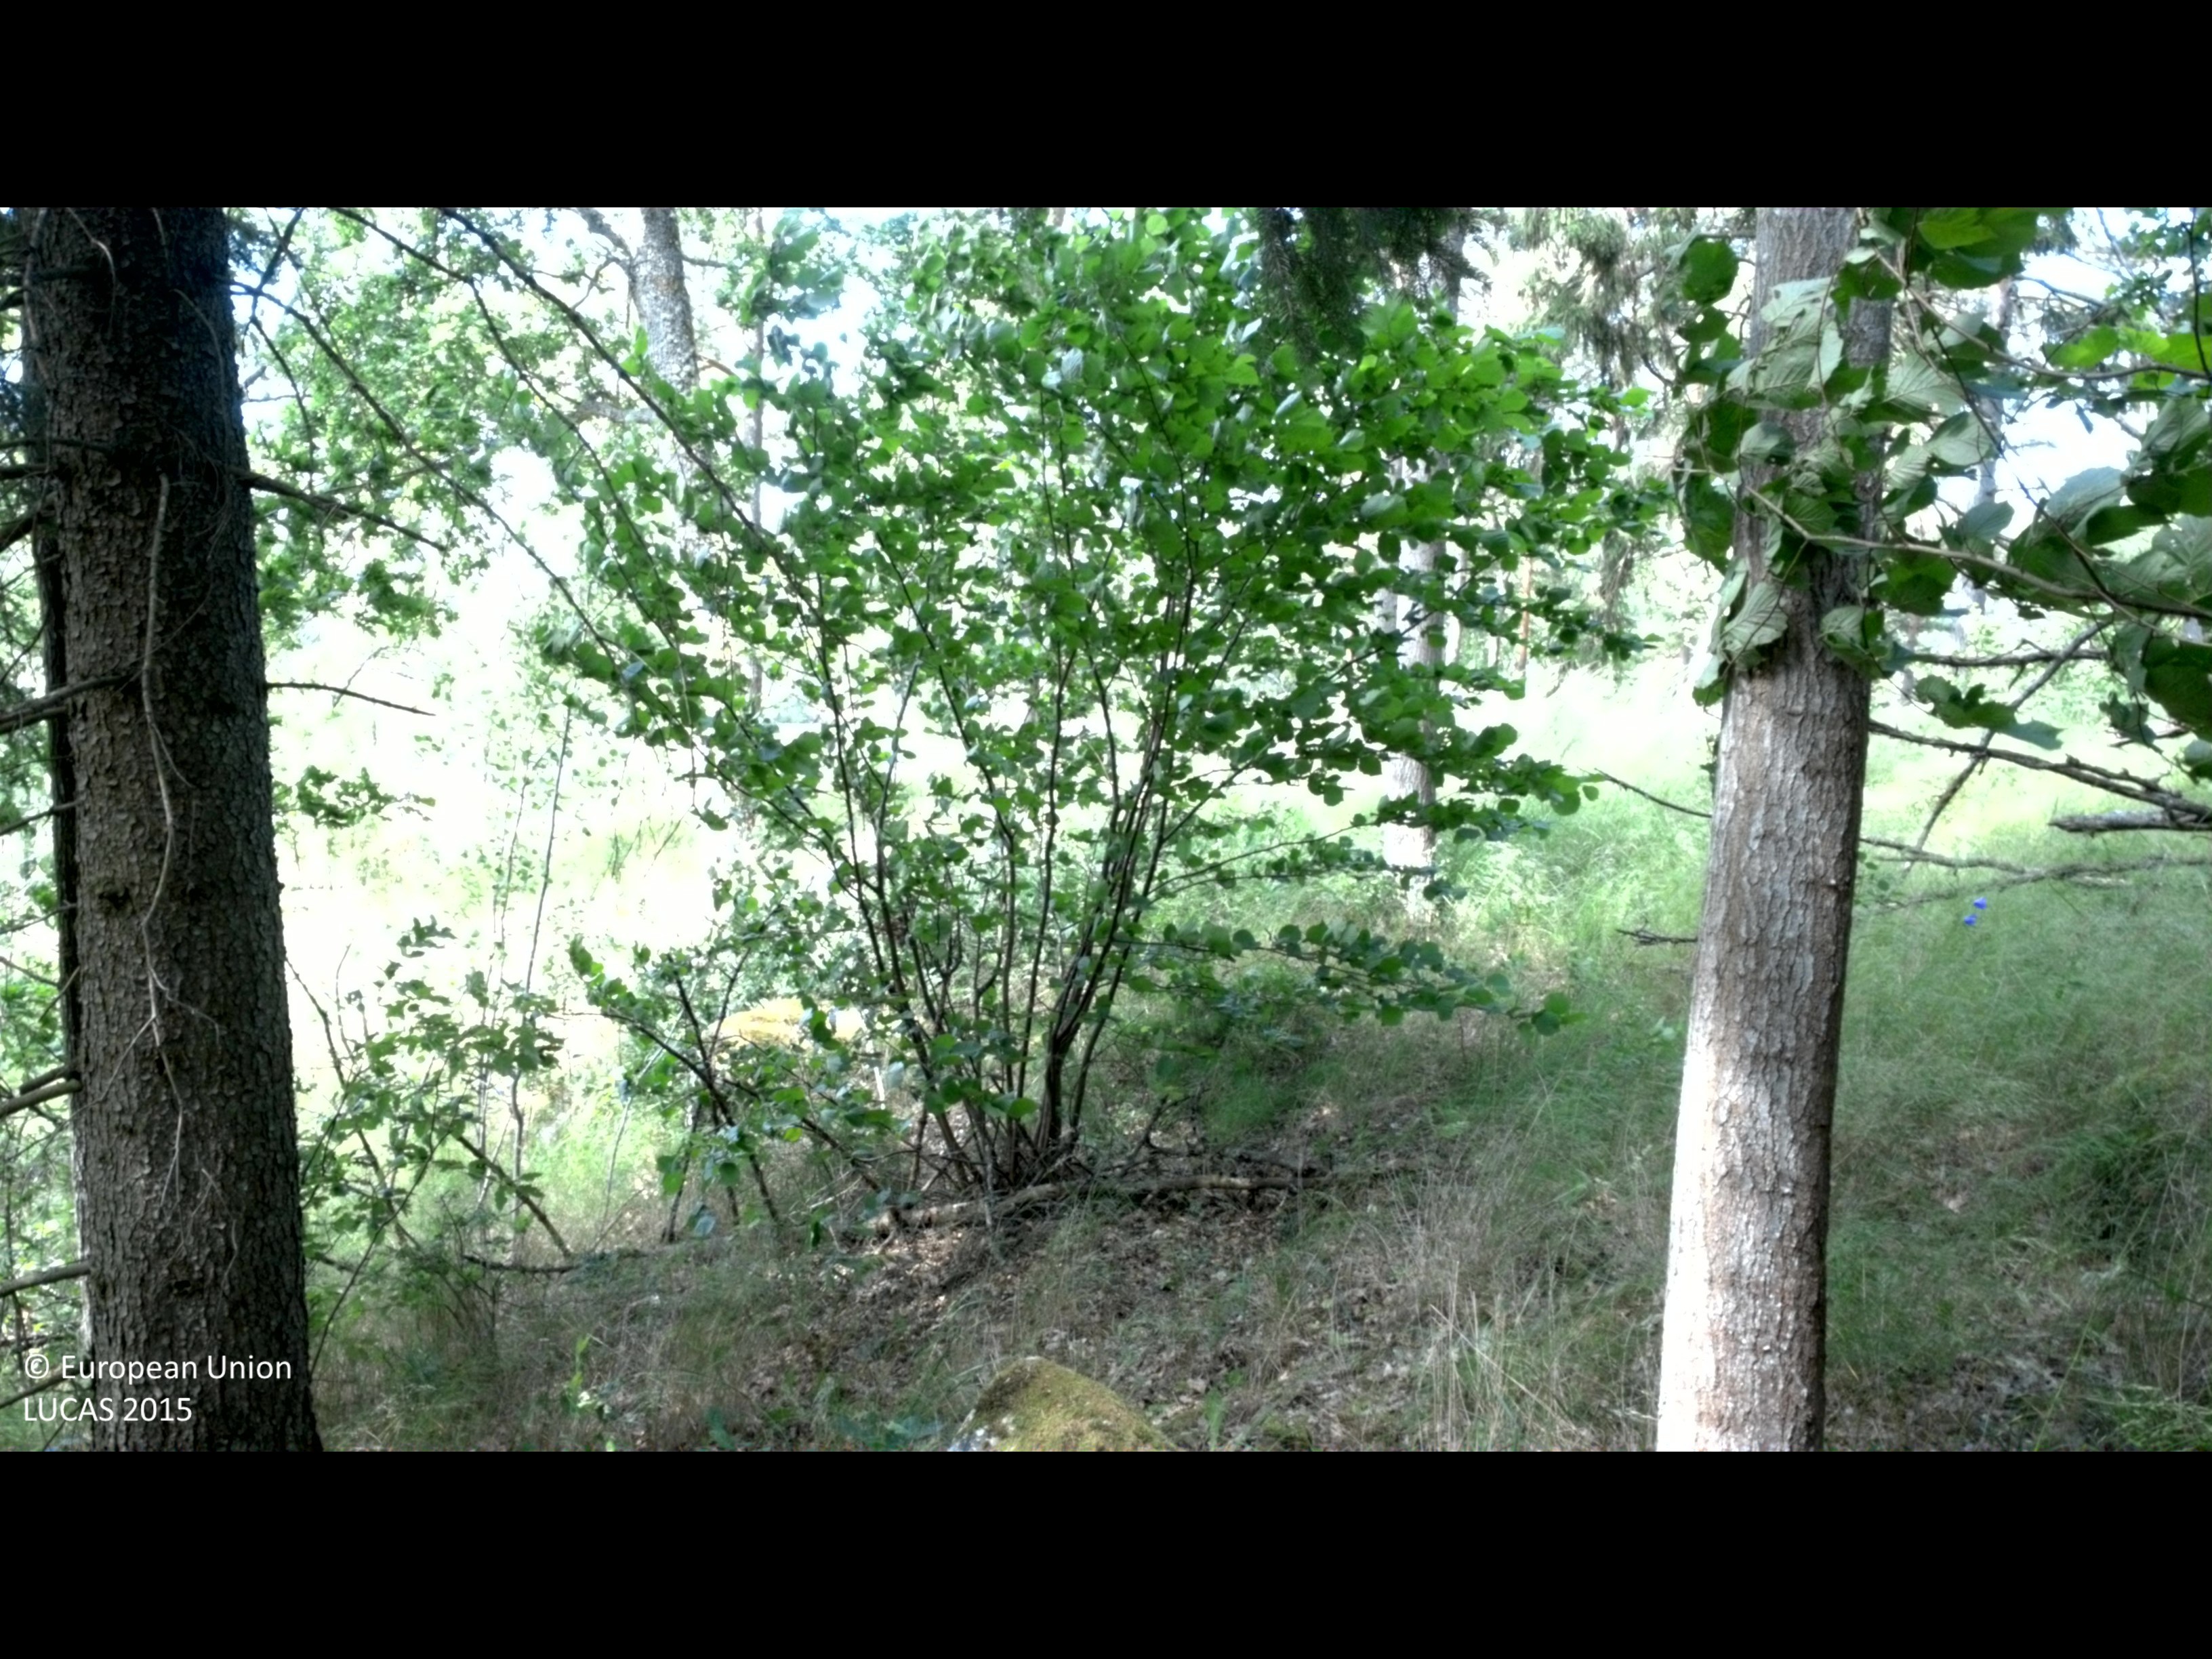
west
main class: Woodland
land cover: Other mixed woodland
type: boreal forest
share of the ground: 50 - 75 %
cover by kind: broadleaved forest trees 40 %, coniferous forest trees 25 %, shrubs 20 %, herbaceous plants 15 %
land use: Forestry
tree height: > 5 m
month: July
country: SE
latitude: 58.2857
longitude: 16.3581
